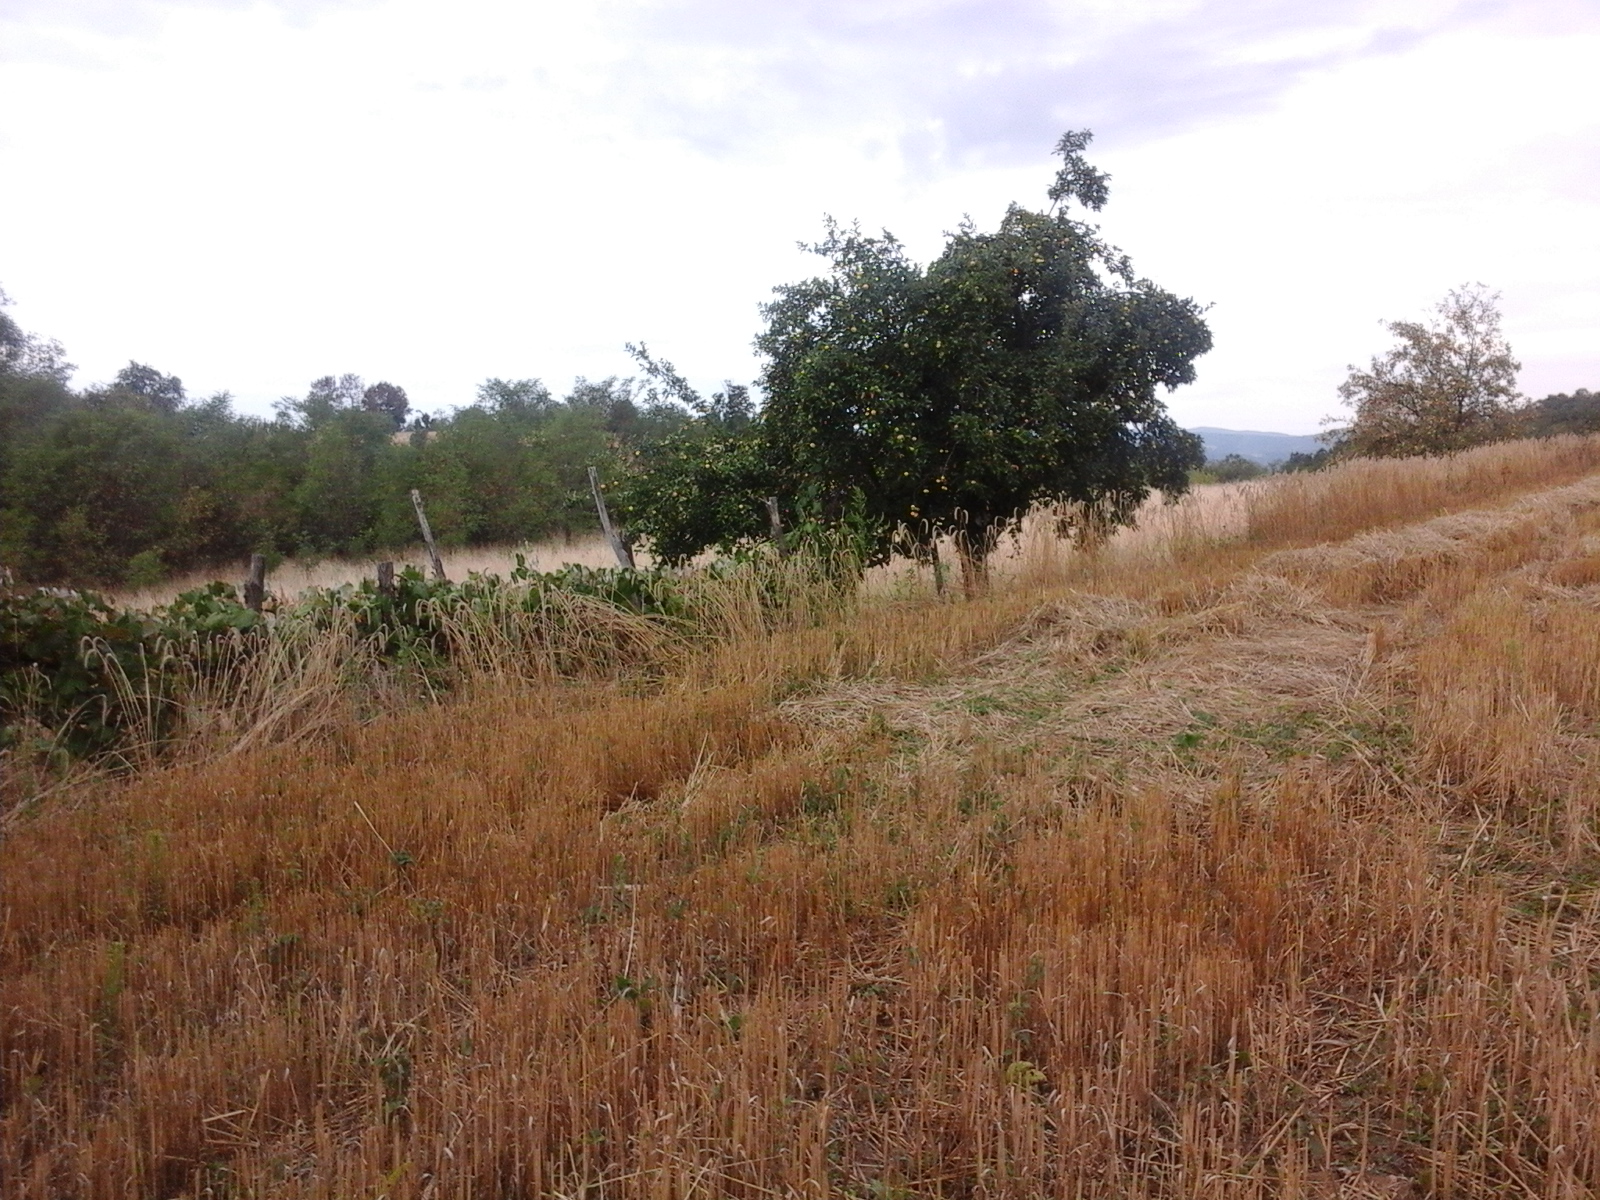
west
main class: Cropland
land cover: Common wheat
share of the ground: > 75 %
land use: Agriculture (excluding fallow land and kitchen gardens)
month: August
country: RO
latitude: 45.2151
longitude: 21.8645
